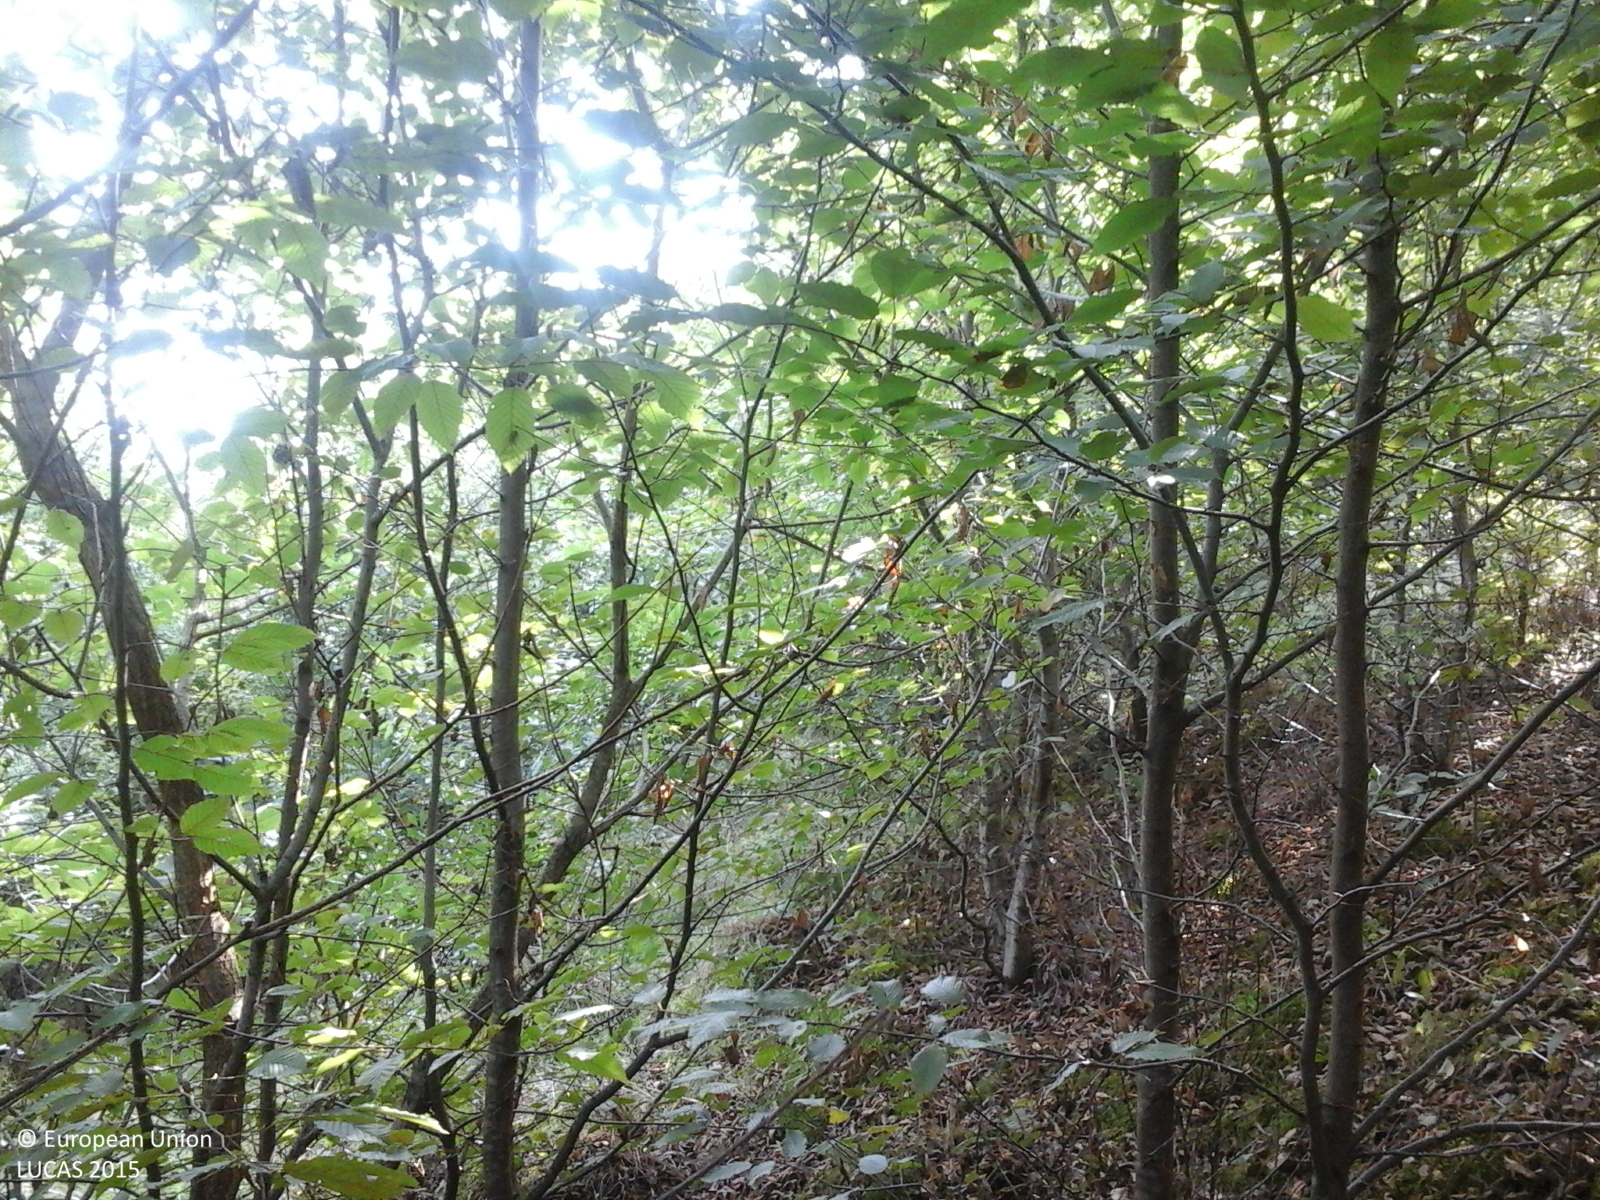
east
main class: Woodland
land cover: Broadleaved woodland
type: mesophytic deciduous forest
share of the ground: > 75 %
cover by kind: broadleaved forest trees 100 %
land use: Forestry
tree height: > 5 m
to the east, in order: Broadleaved woodland; Grassland with sparse tree/shrub cover; Broadleaved woodland; Grassland with sparse tree/shrub cover; Shrubland without tree cover; Grassland without tree/shrub cover
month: September
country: RO
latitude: 47.0779
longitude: 23.3575
